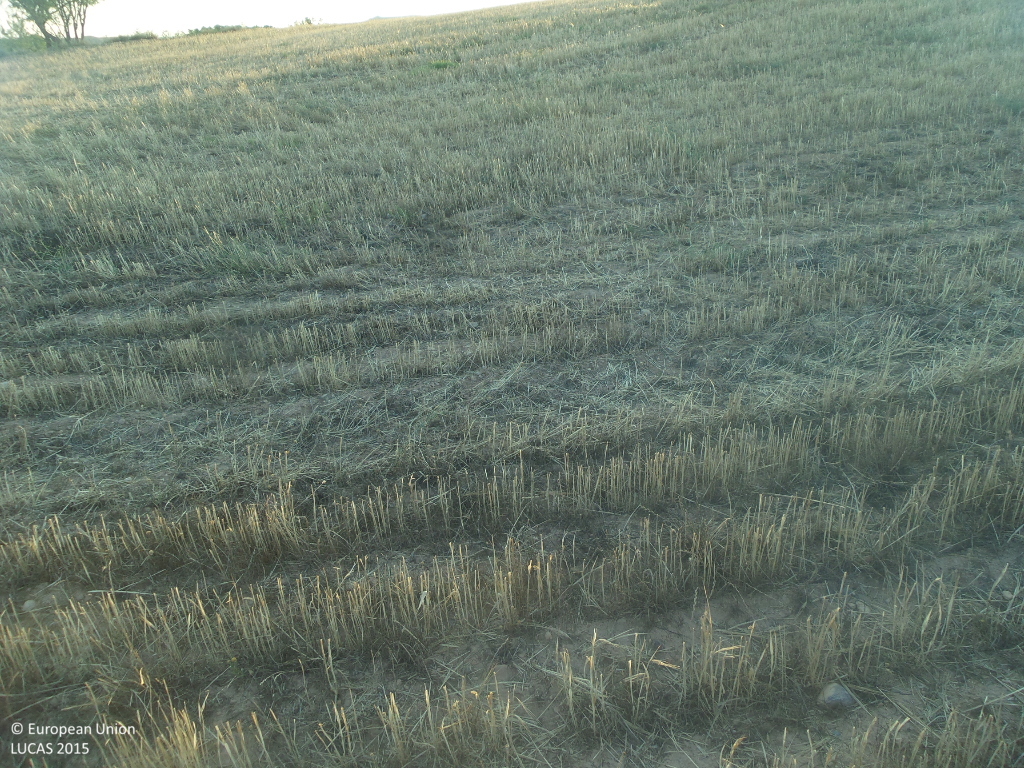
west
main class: Cropland
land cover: Barley
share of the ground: < 10 %
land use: Agriculture (excluding fallow land and kitchen gardens)
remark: Harvested field
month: July
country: ES
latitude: 41.3048
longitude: -2.1043
